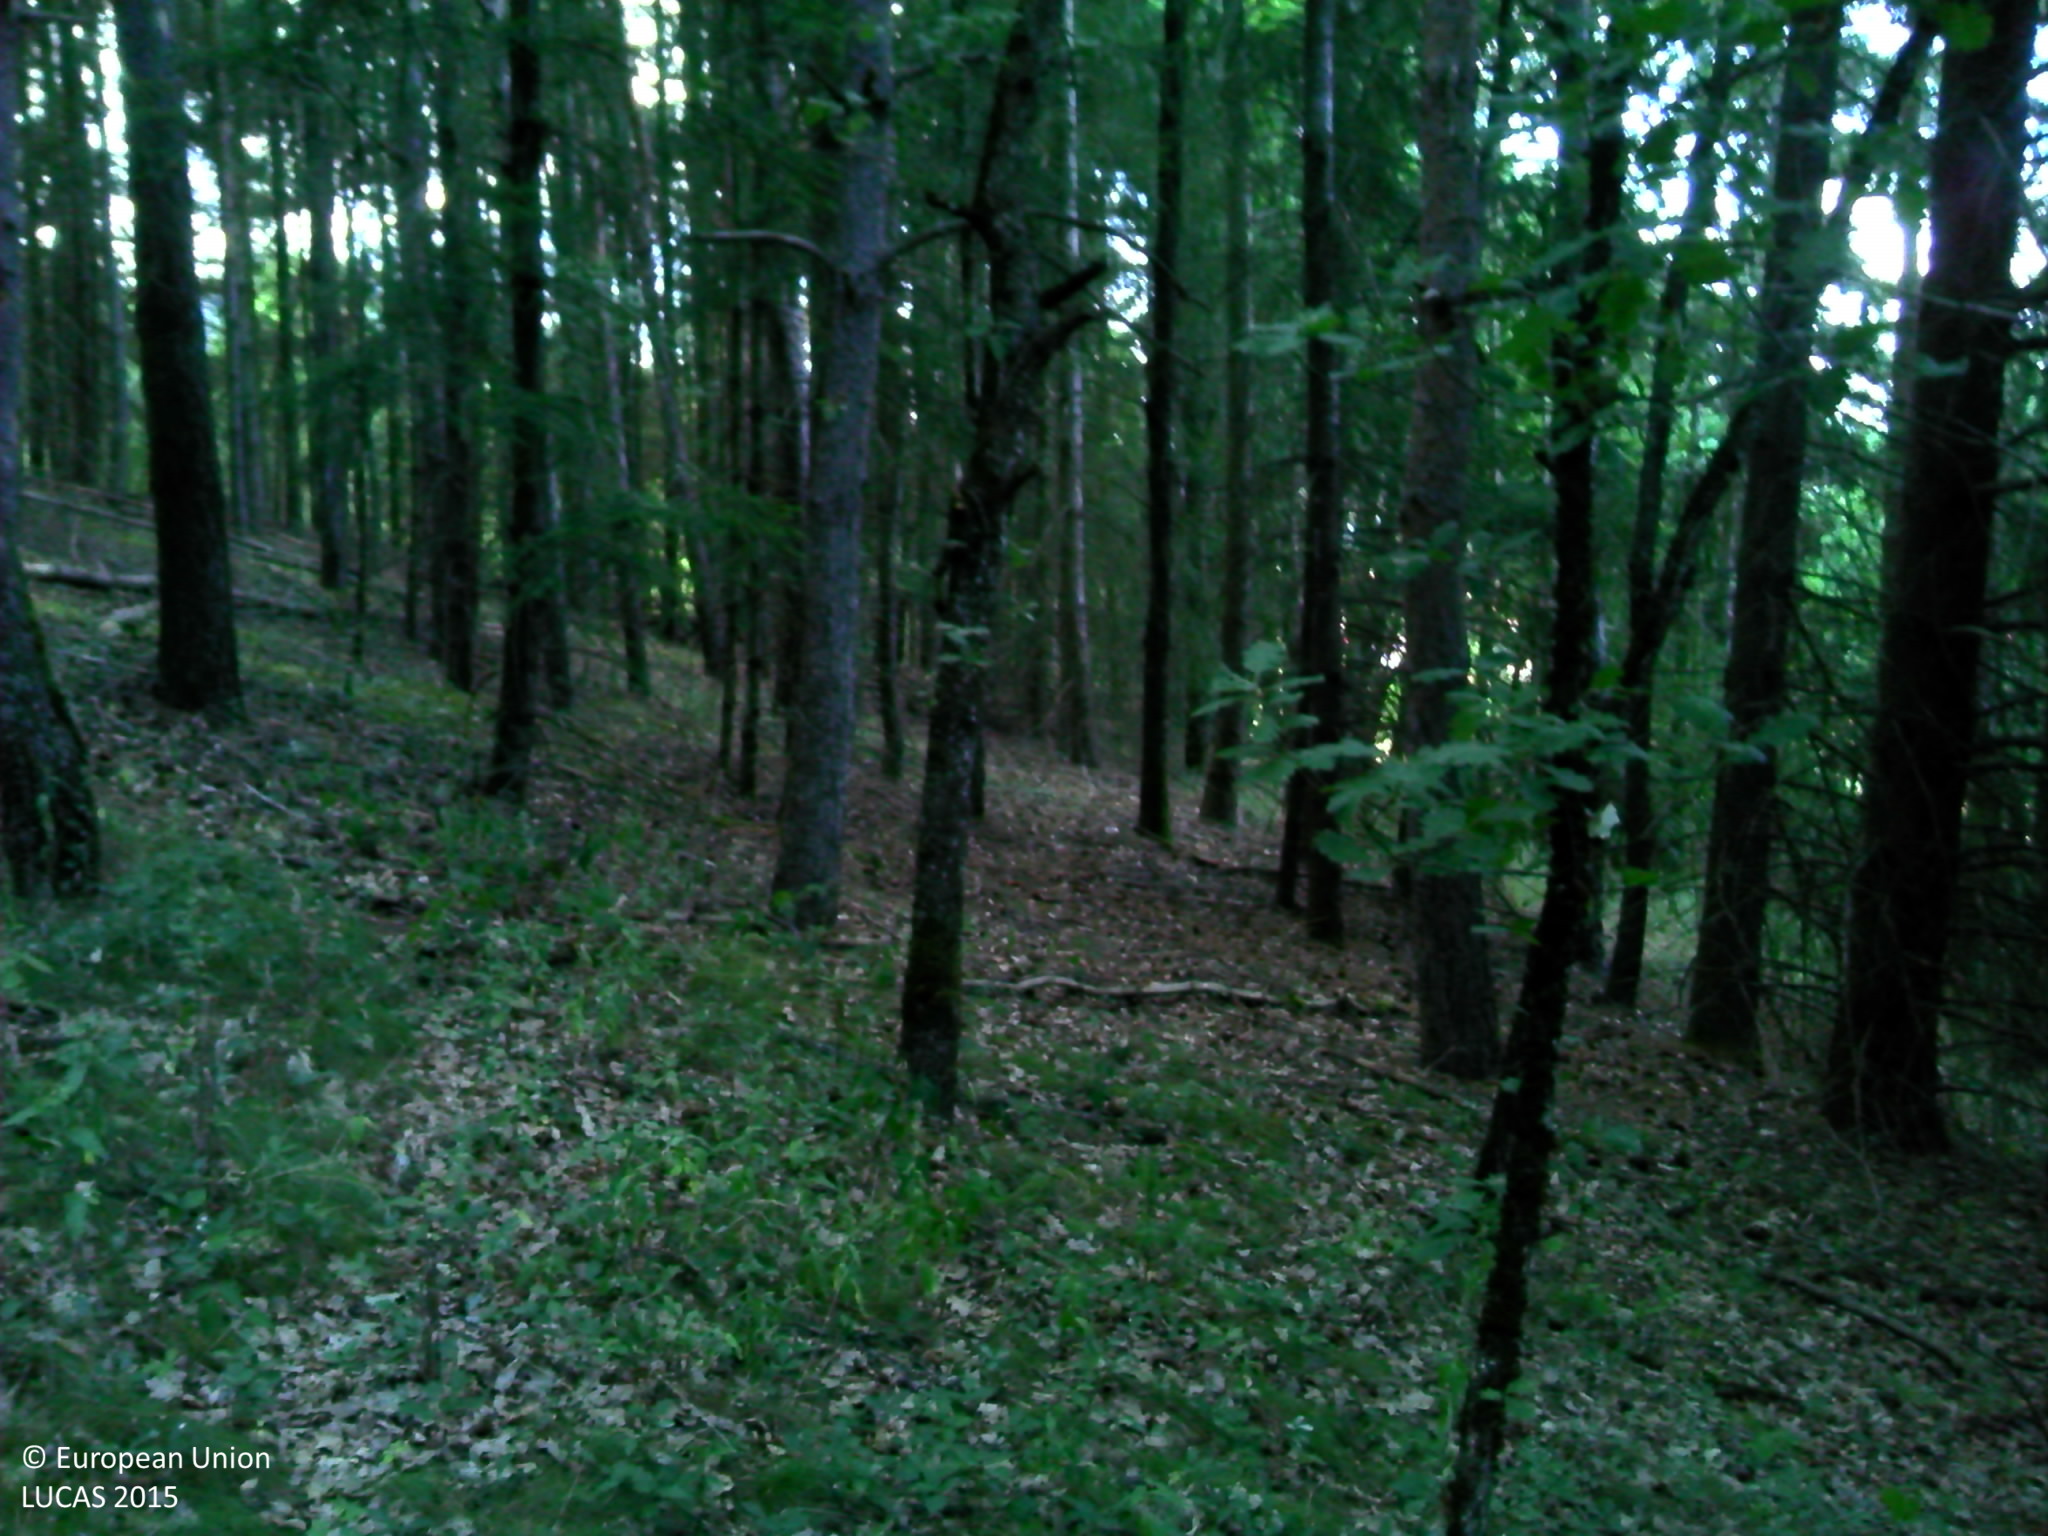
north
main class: Woodland
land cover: Spruce dominated mixed woodland
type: acidophilous oak and oak-birch forest
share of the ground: > 75 %
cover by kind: coniferous forest trees 75 %, broadleaved forest trees 25 %
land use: Forestry
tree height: > 5 m
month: July
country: FR
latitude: 45.1221
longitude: 3.4813
